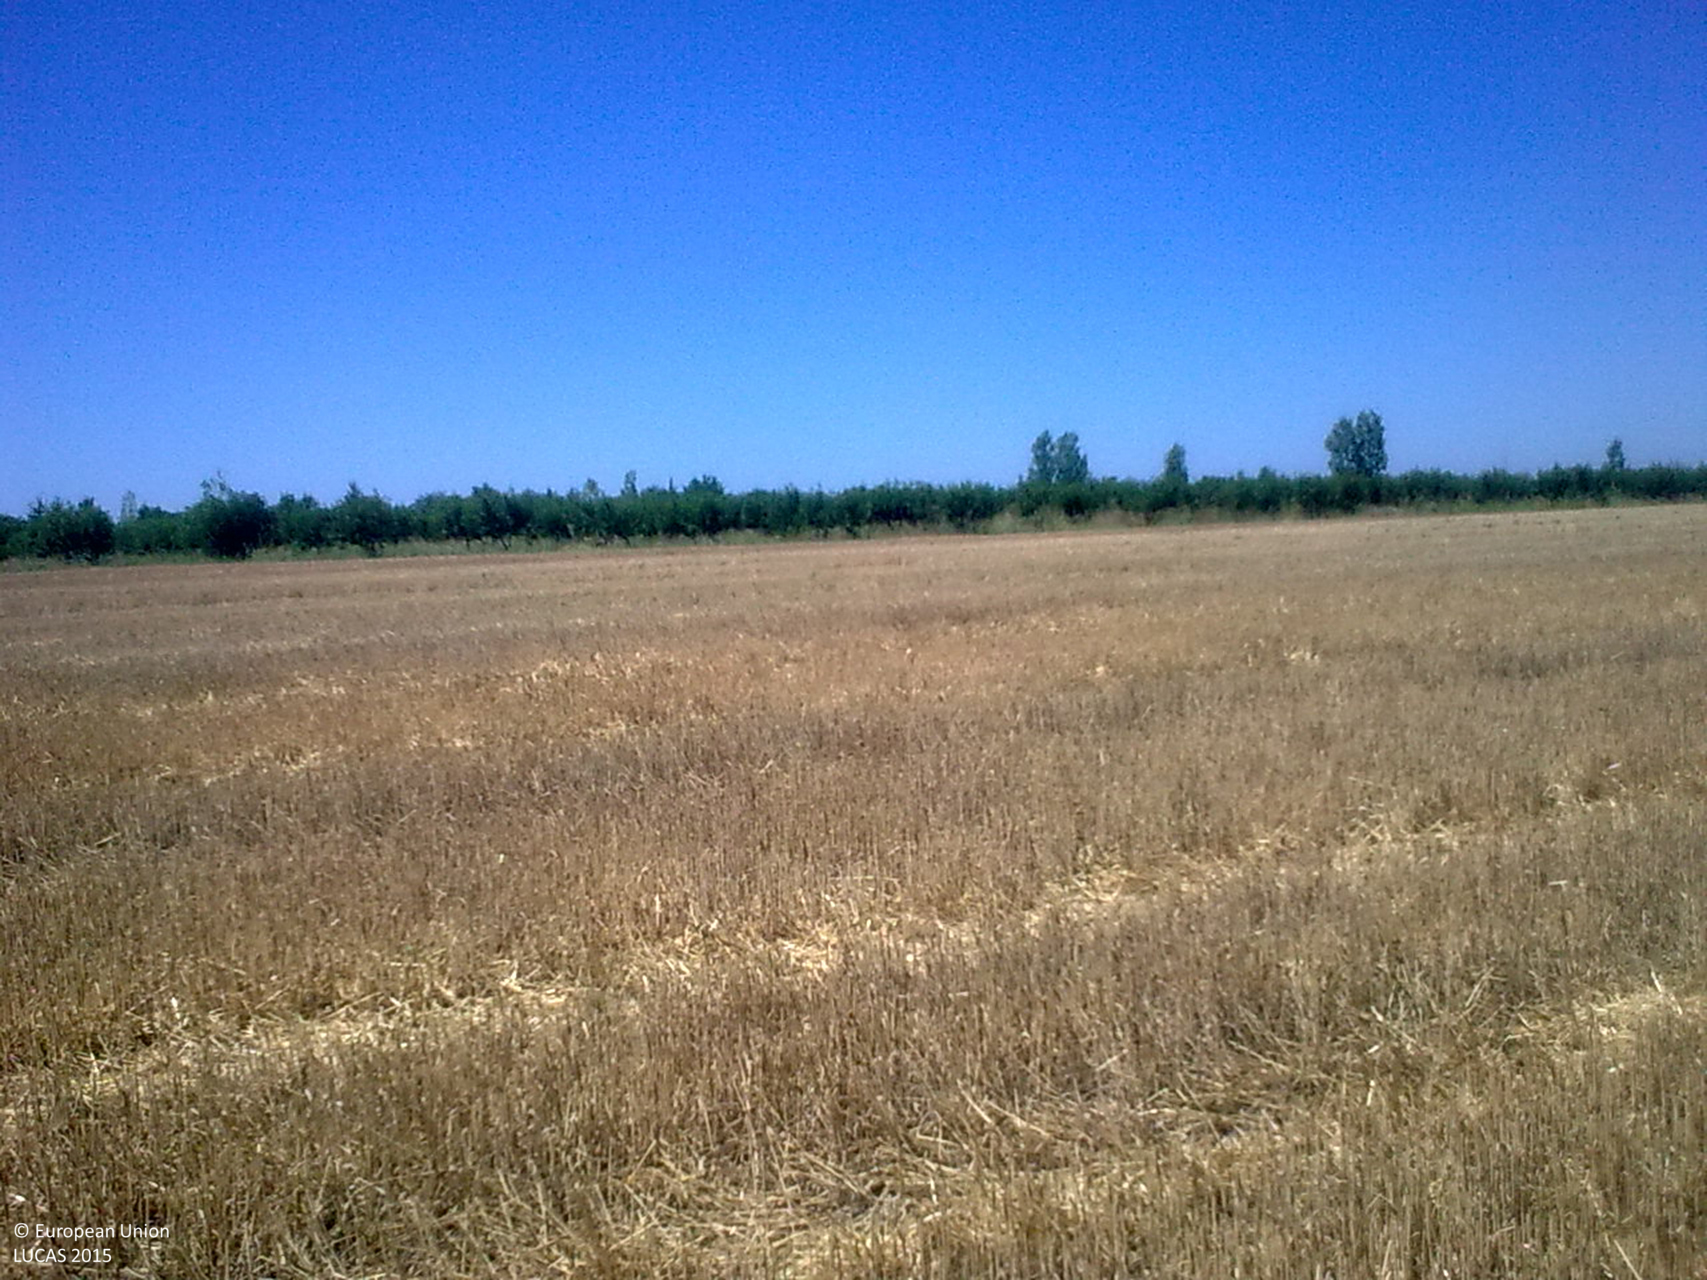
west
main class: Cropland
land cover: Common wheat
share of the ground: 50 - 75 %
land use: Agriculture (excluding fallow land and kitchen gardens)
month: July
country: BG
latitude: 43.9001
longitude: 26.2762
